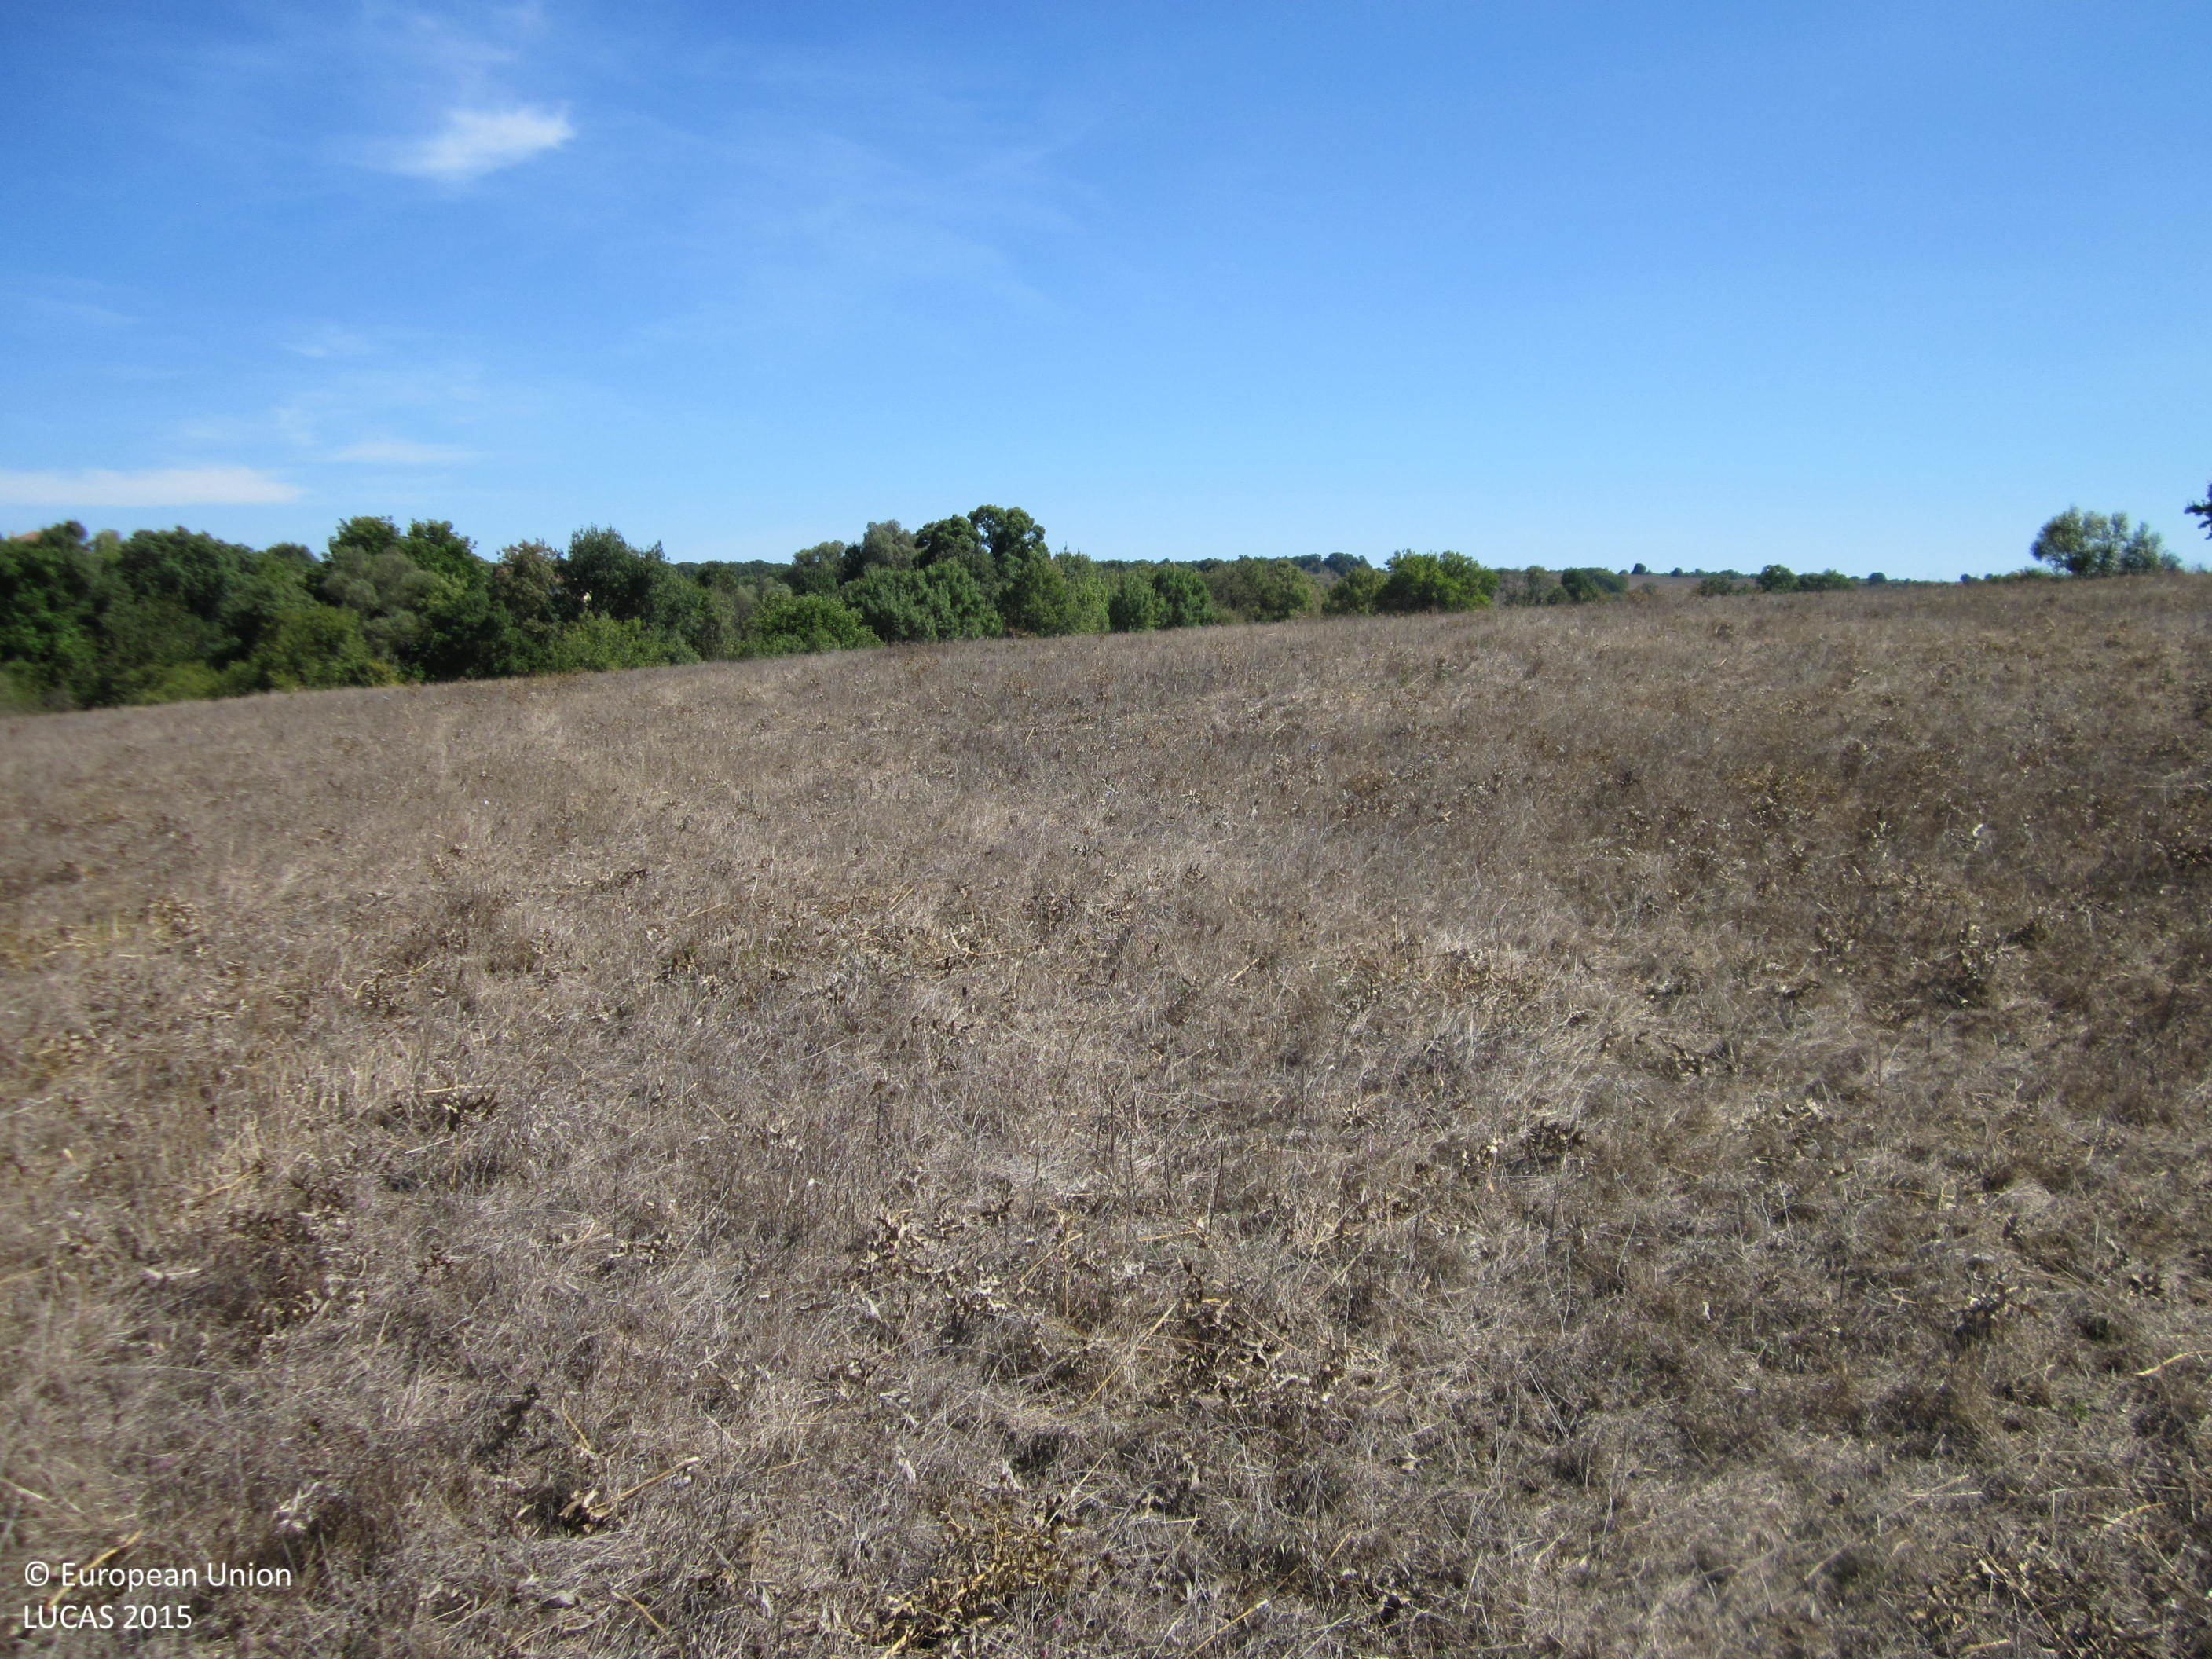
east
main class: Grassland
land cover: Grassland without tree/shrub cover
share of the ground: > 75 %
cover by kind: herbaceous plants 100 %
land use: Agriculture (excluding fallow land and kitchen gardens)
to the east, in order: Grassland without tree/shrub cover; Broadleaved woodland; Rivers and streams; Broadleaved woodland; Grassland without tree/shrub cover; Broadleaved woodland; Rivers and streams; Broadleaved woodland
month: September
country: BG
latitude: 42.2430
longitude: 26.9576
